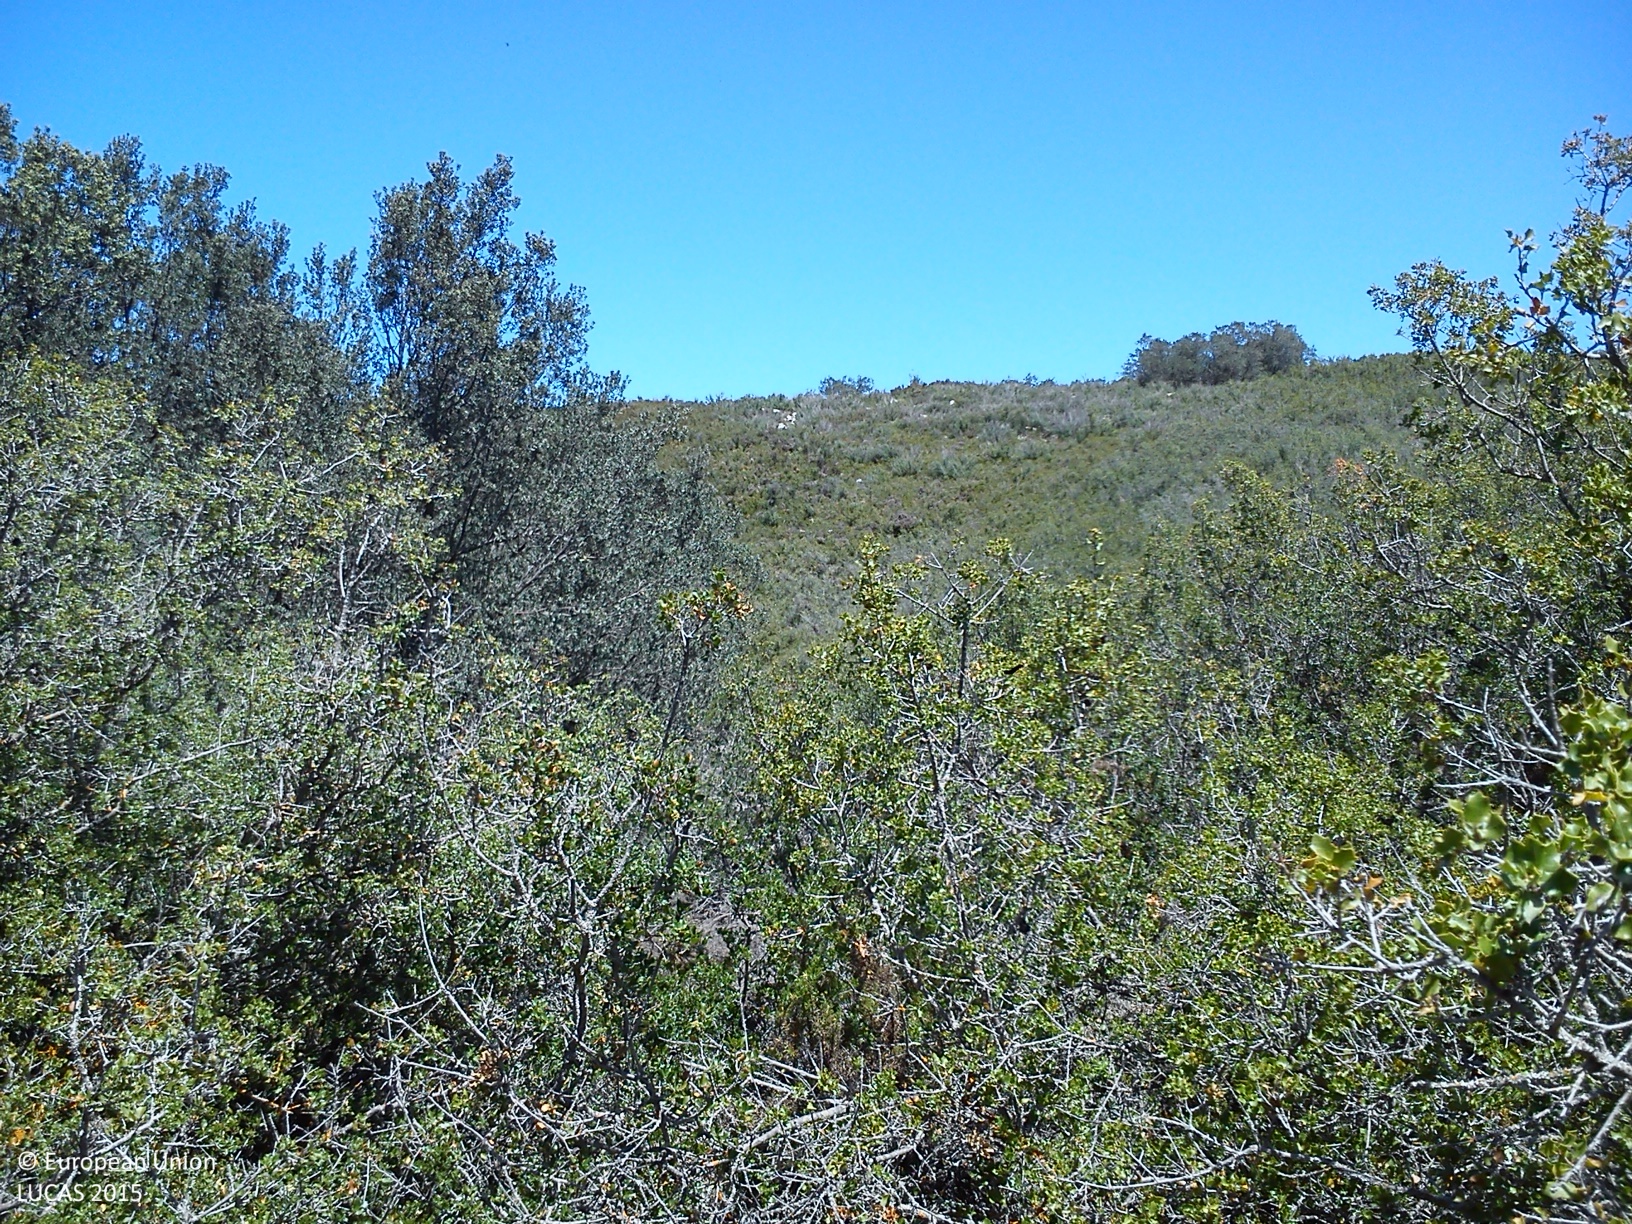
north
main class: Shrubland
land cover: Shrubland with sparse tree cover
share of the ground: > 75 %
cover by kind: shrubs 90 %, coniferous forest trees 5 %, consolidated bare surface 5 %
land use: Semi-natural and natural areas not in use
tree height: < 5 m
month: May
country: ES
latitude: 39.5328
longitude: -0.8787
